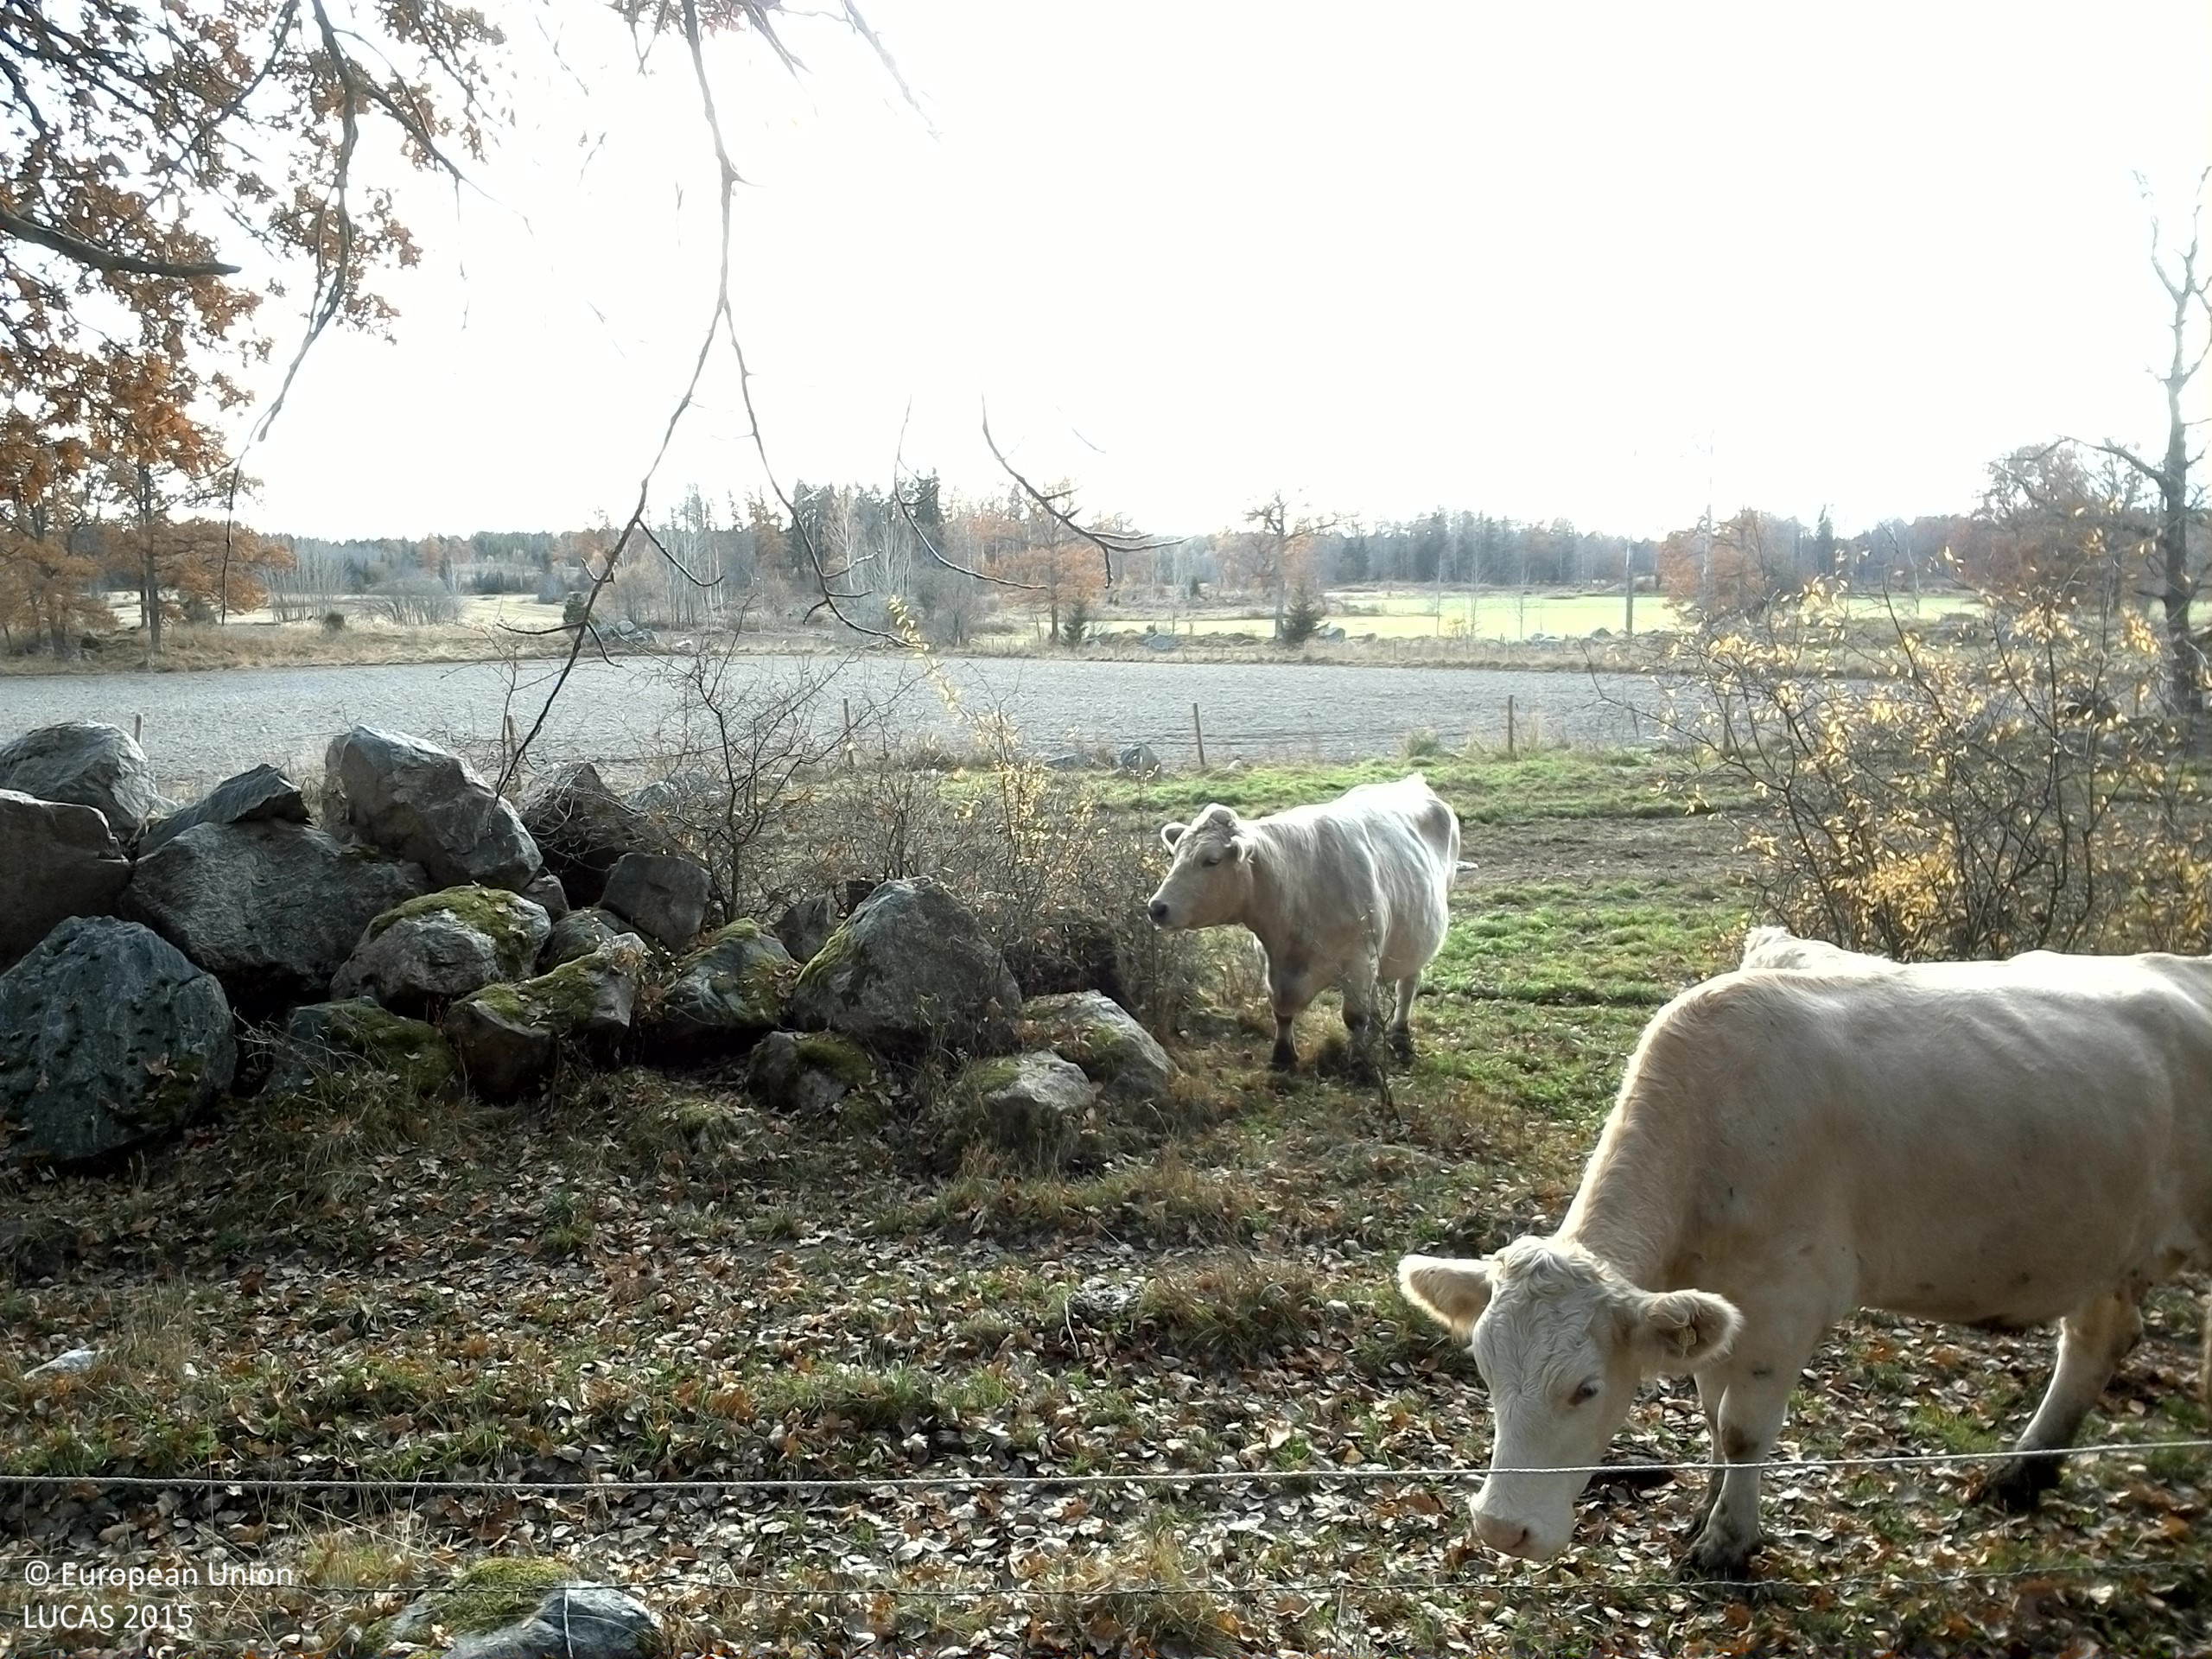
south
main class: Woodland
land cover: Pine dominated mixed woodland
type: boreal forest
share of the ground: 50 - 75 %
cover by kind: coniferous forest trees 25 %, broadleaved forest trees 25 %, herbaceous plants 25 %, shrubs 15 %, consolidated bare surface 10 %
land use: Forestry
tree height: > 5 m
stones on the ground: < 10 %
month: October
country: SE
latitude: 59.3105
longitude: 16.8272
